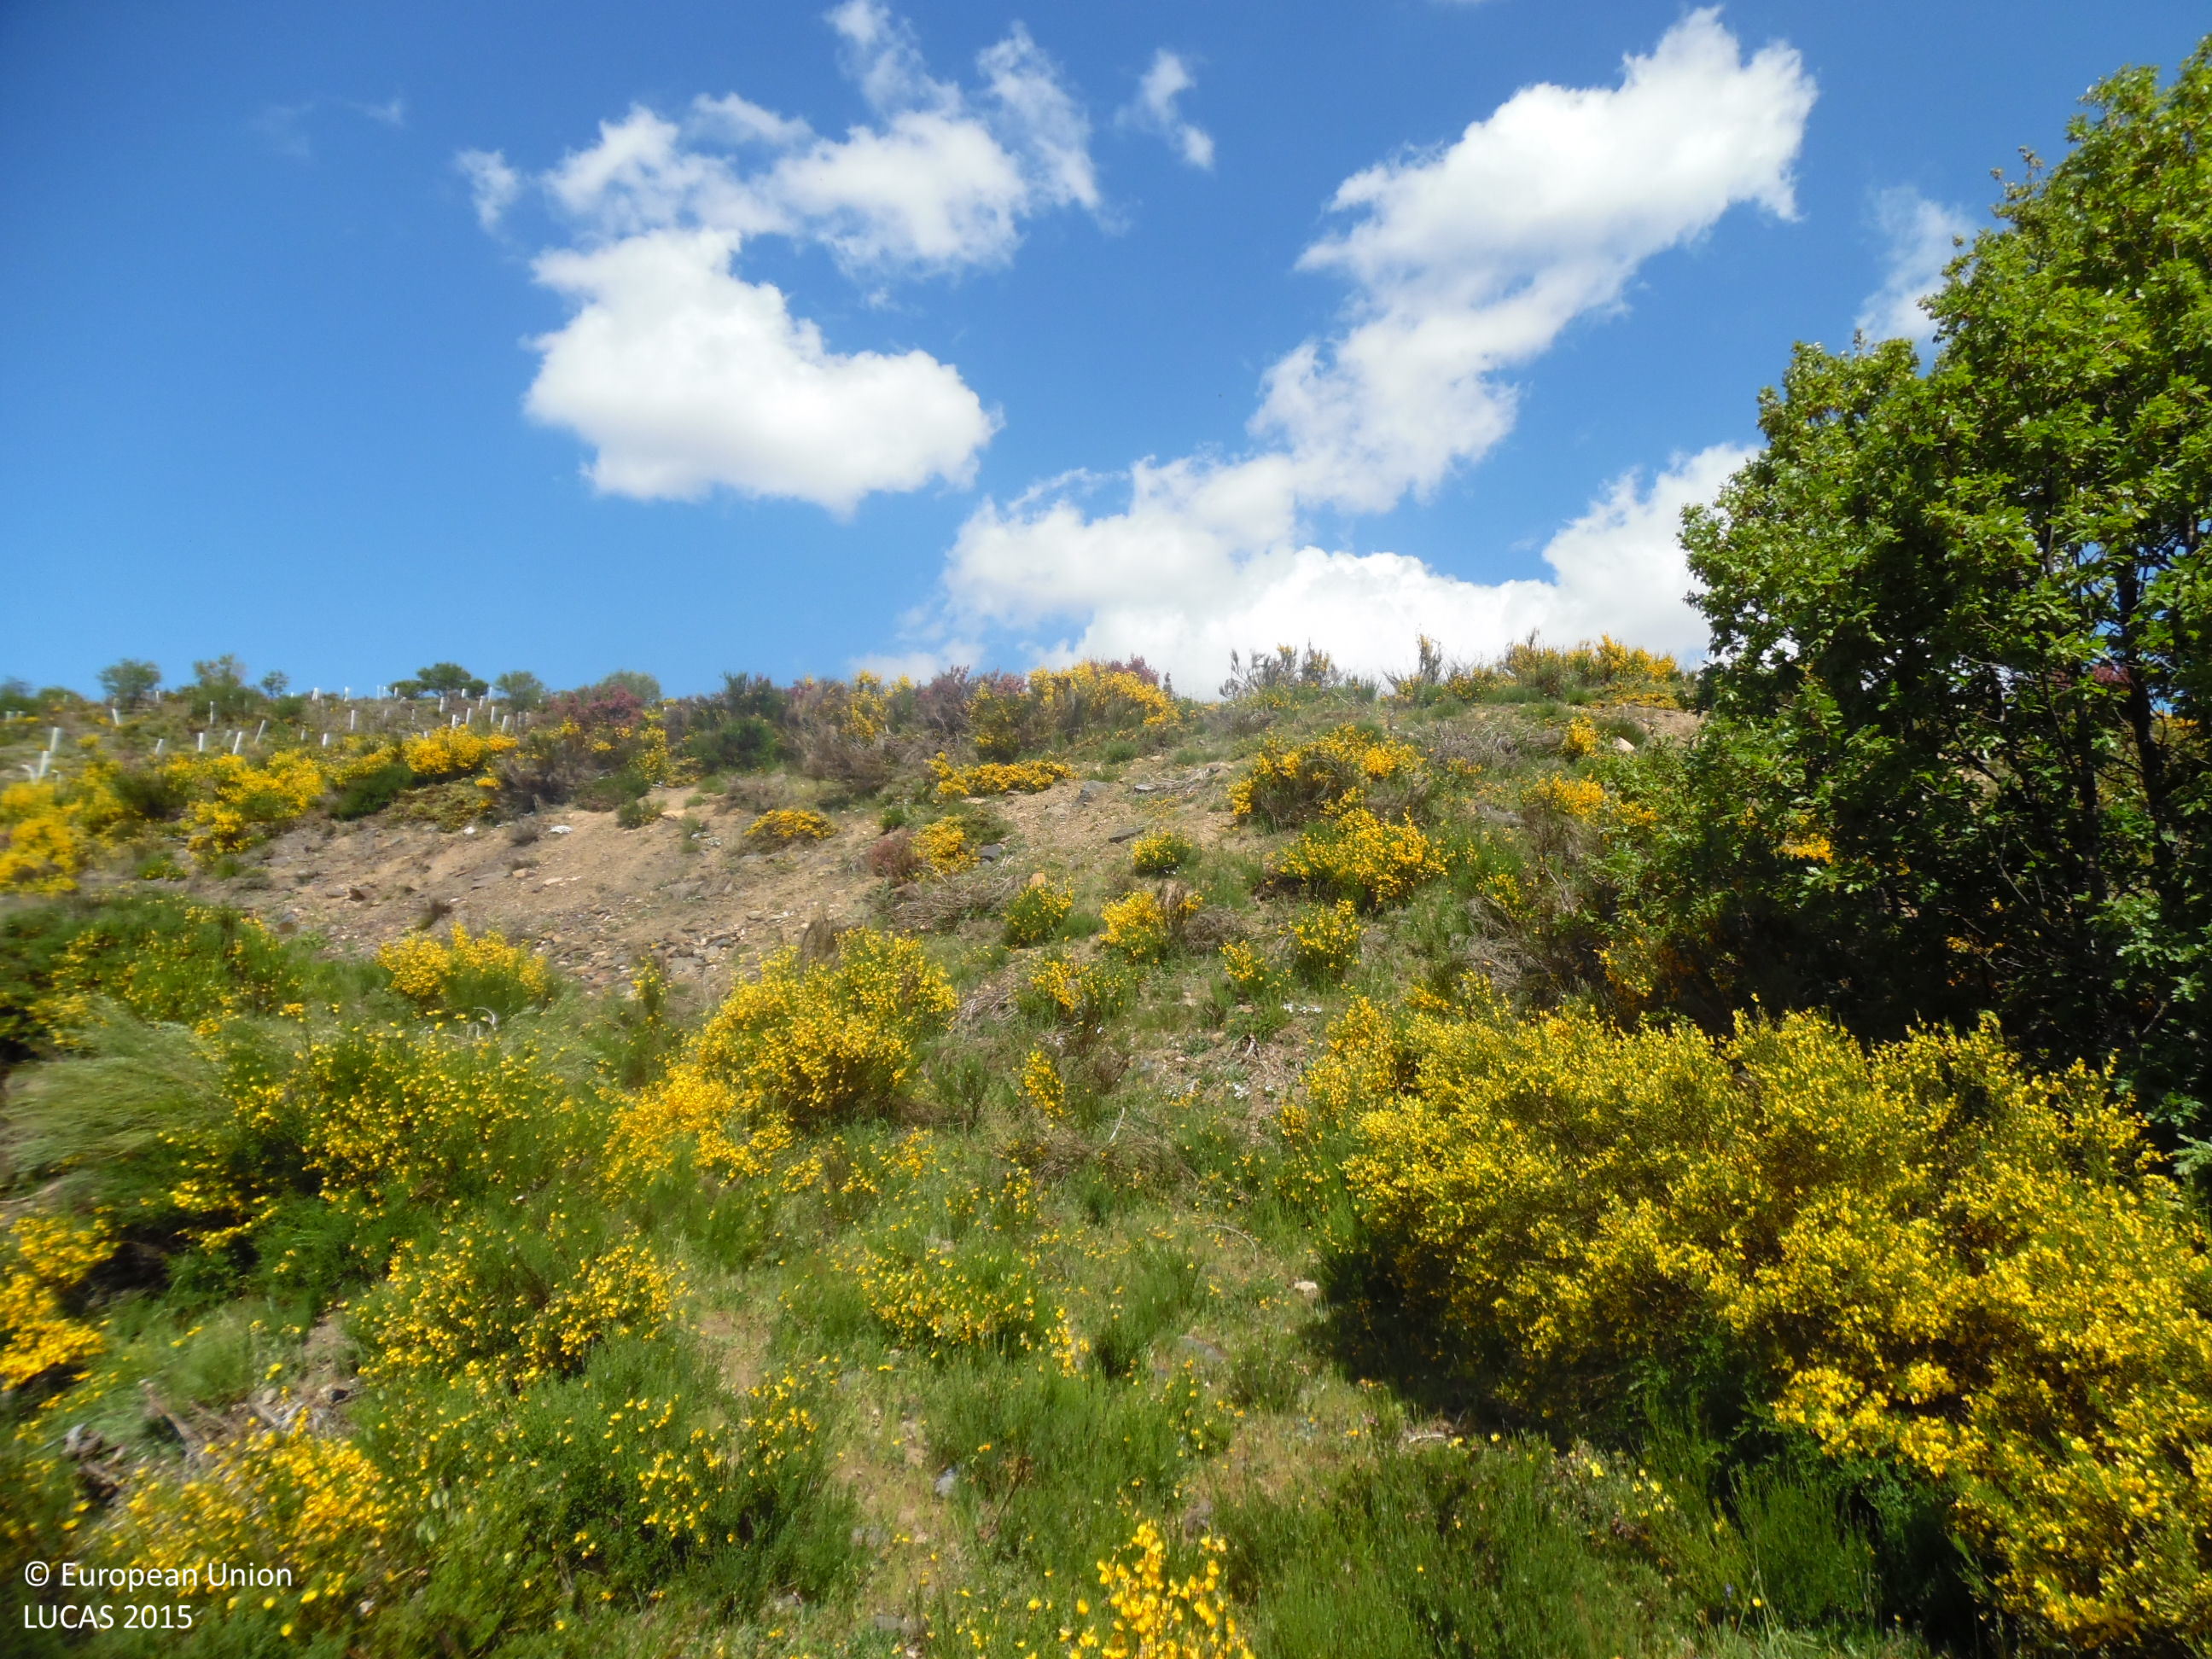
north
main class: Woodland
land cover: Broadleaved woodland
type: thermophilous deciduous forest
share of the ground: > 75 %
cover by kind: broadleaved forest trees 95 %, shrubs 5 %
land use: Forestry
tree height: > 5 m
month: May
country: ES
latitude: 42.9516
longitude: -6.2343
